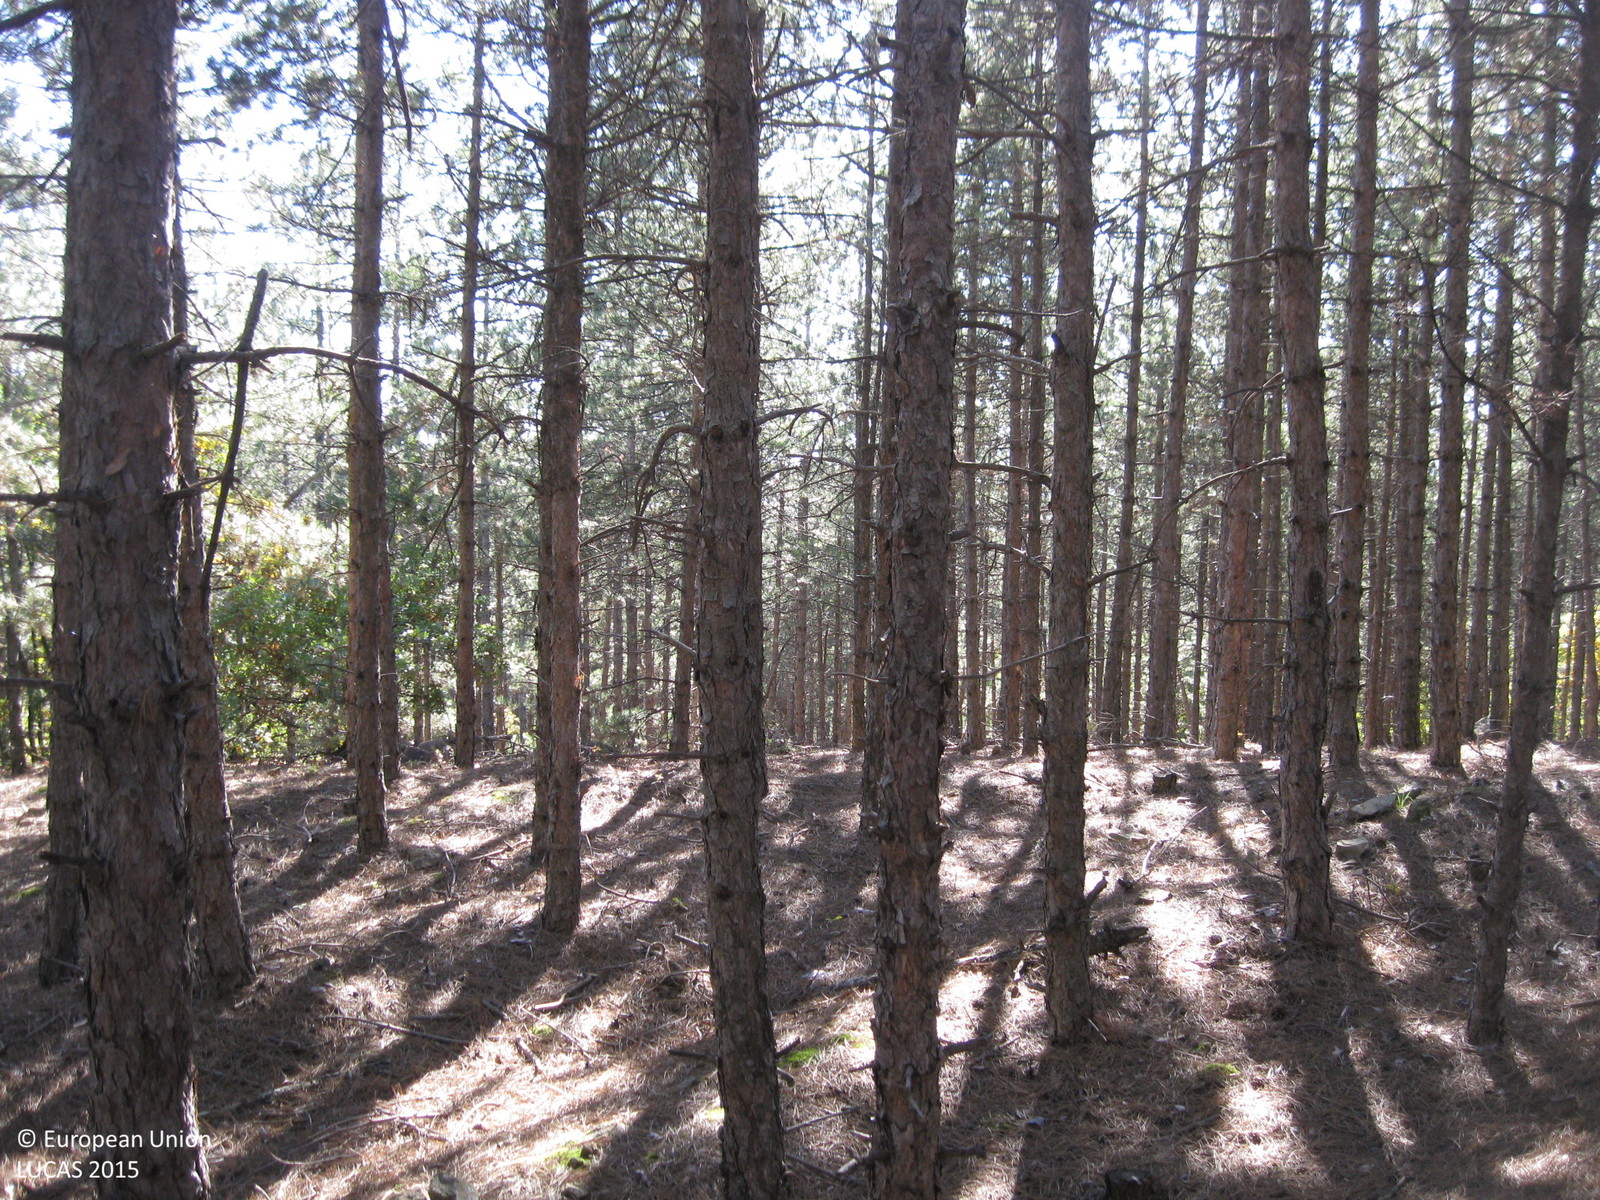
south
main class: Woodland
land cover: Pine dominated coniferous woodland
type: hemiboreal forest and nemoral coniferous forest and mixed broadleaved-coniferous forest
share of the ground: > 75 %
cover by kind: coniferous forest trees 95 %, unconsolidated bare surface 5 %
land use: Forestry
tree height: > 5 m
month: November
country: BG
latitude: 42.3346
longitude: 24.1336
